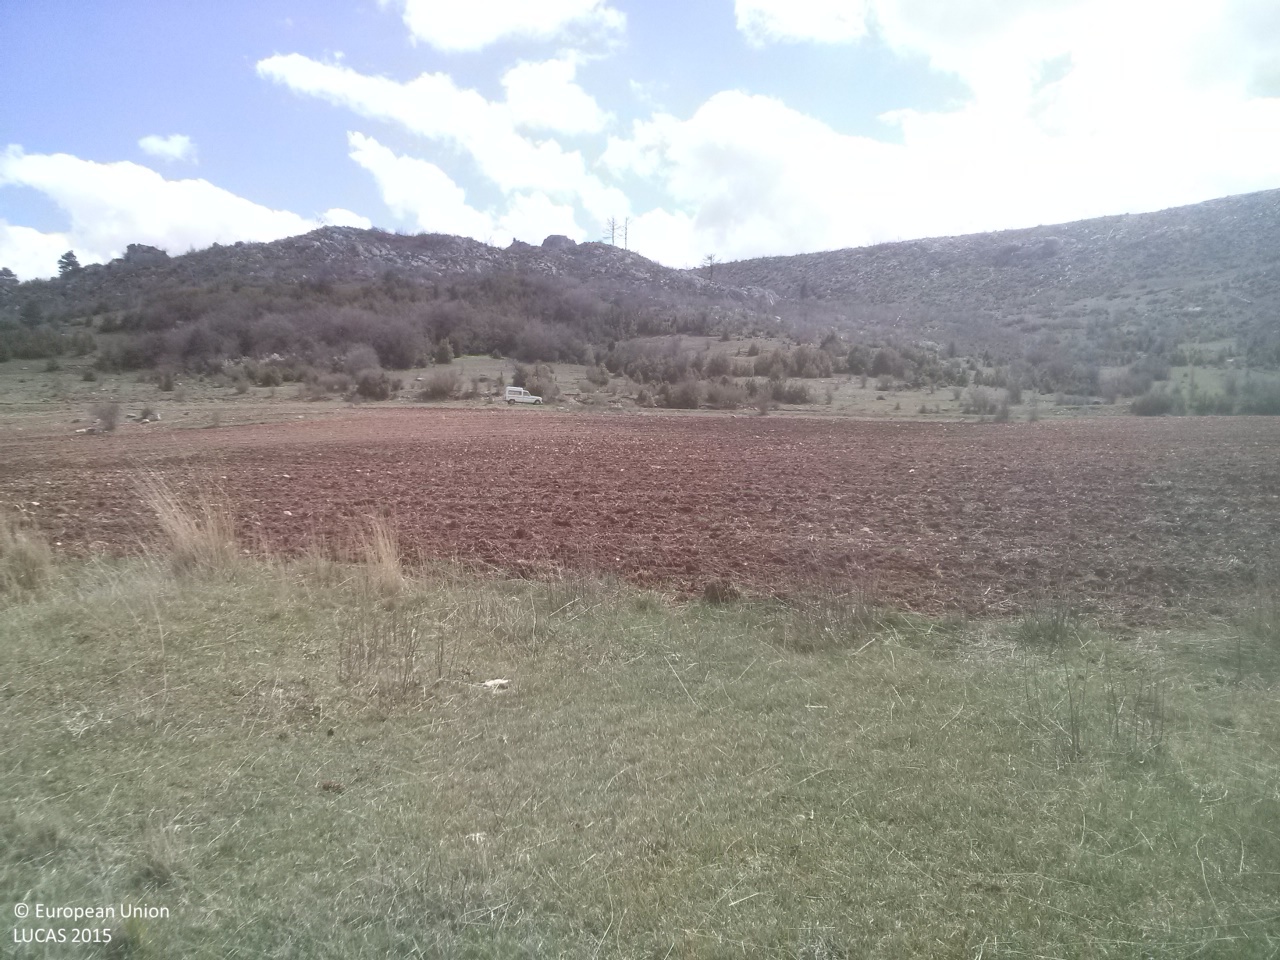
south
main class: Grassland
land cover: Grassland without tree/shrub cover
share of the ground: > 75 %
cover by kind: herbaceous plants 85 %, unconsolidated bare surface 15 %
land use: Agriculture (excluding fallow land and kitchen gardens)
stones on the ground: < 10 %
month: April
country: ES
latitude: 40.4460
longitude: -1.9621
